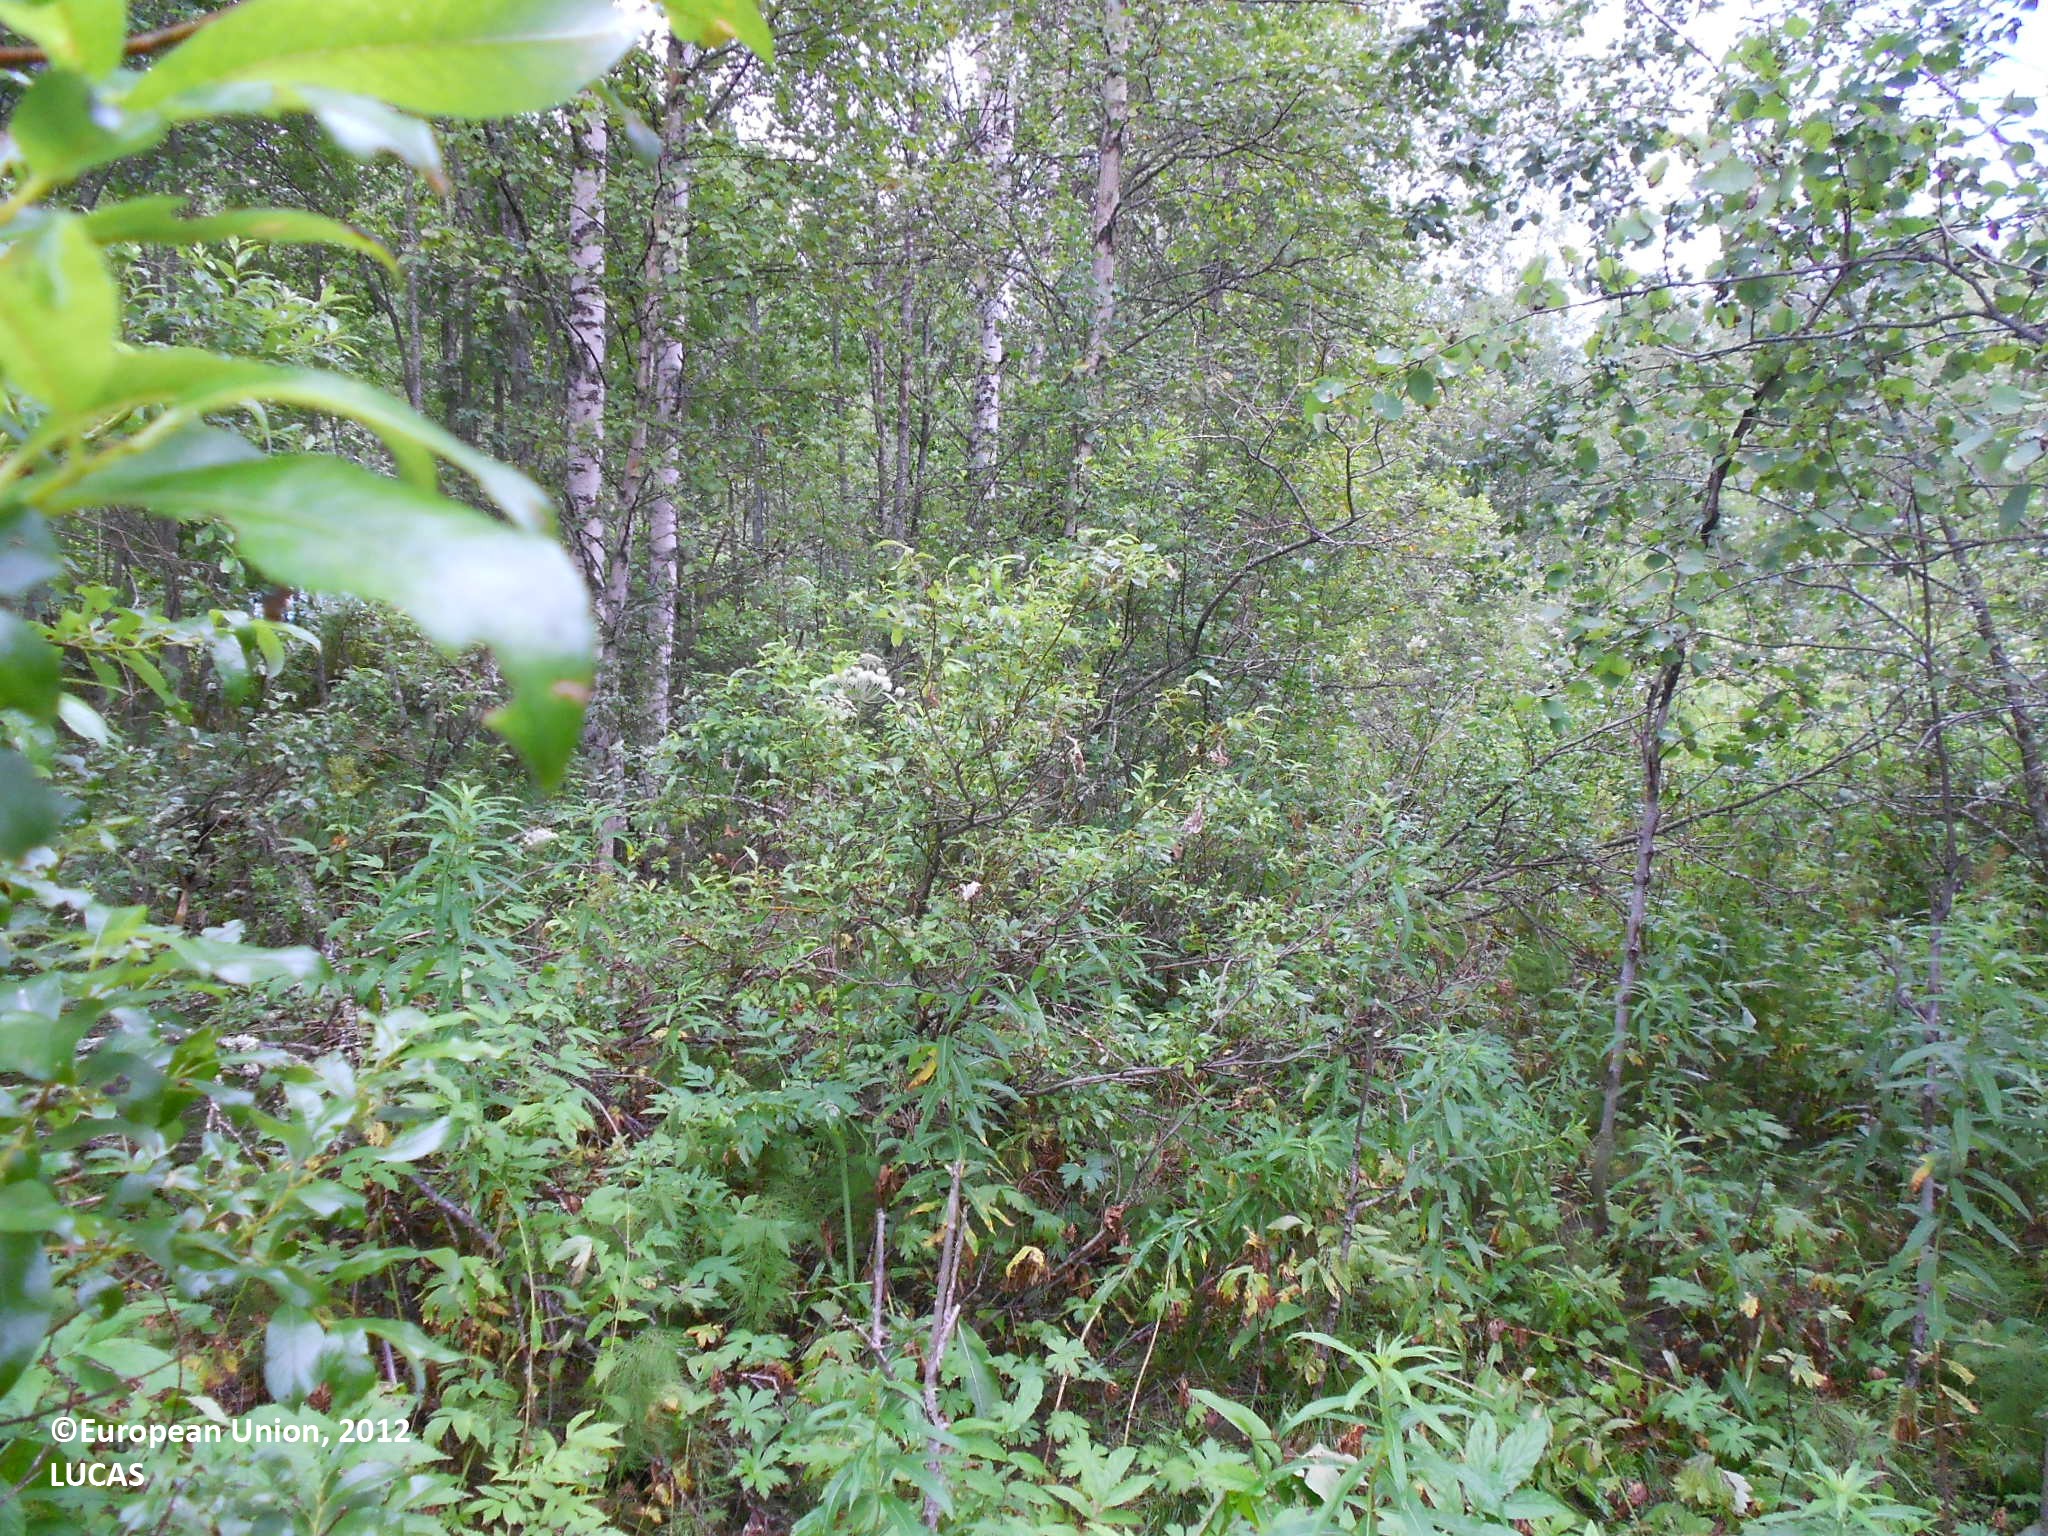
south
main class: Woodland
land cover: Broadleaved woodland
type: boreal forest
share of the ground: 50 - 75 %
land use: Forestry
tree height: > 5 m
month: August
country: FI
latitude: 63.5050
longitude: 28.9092
